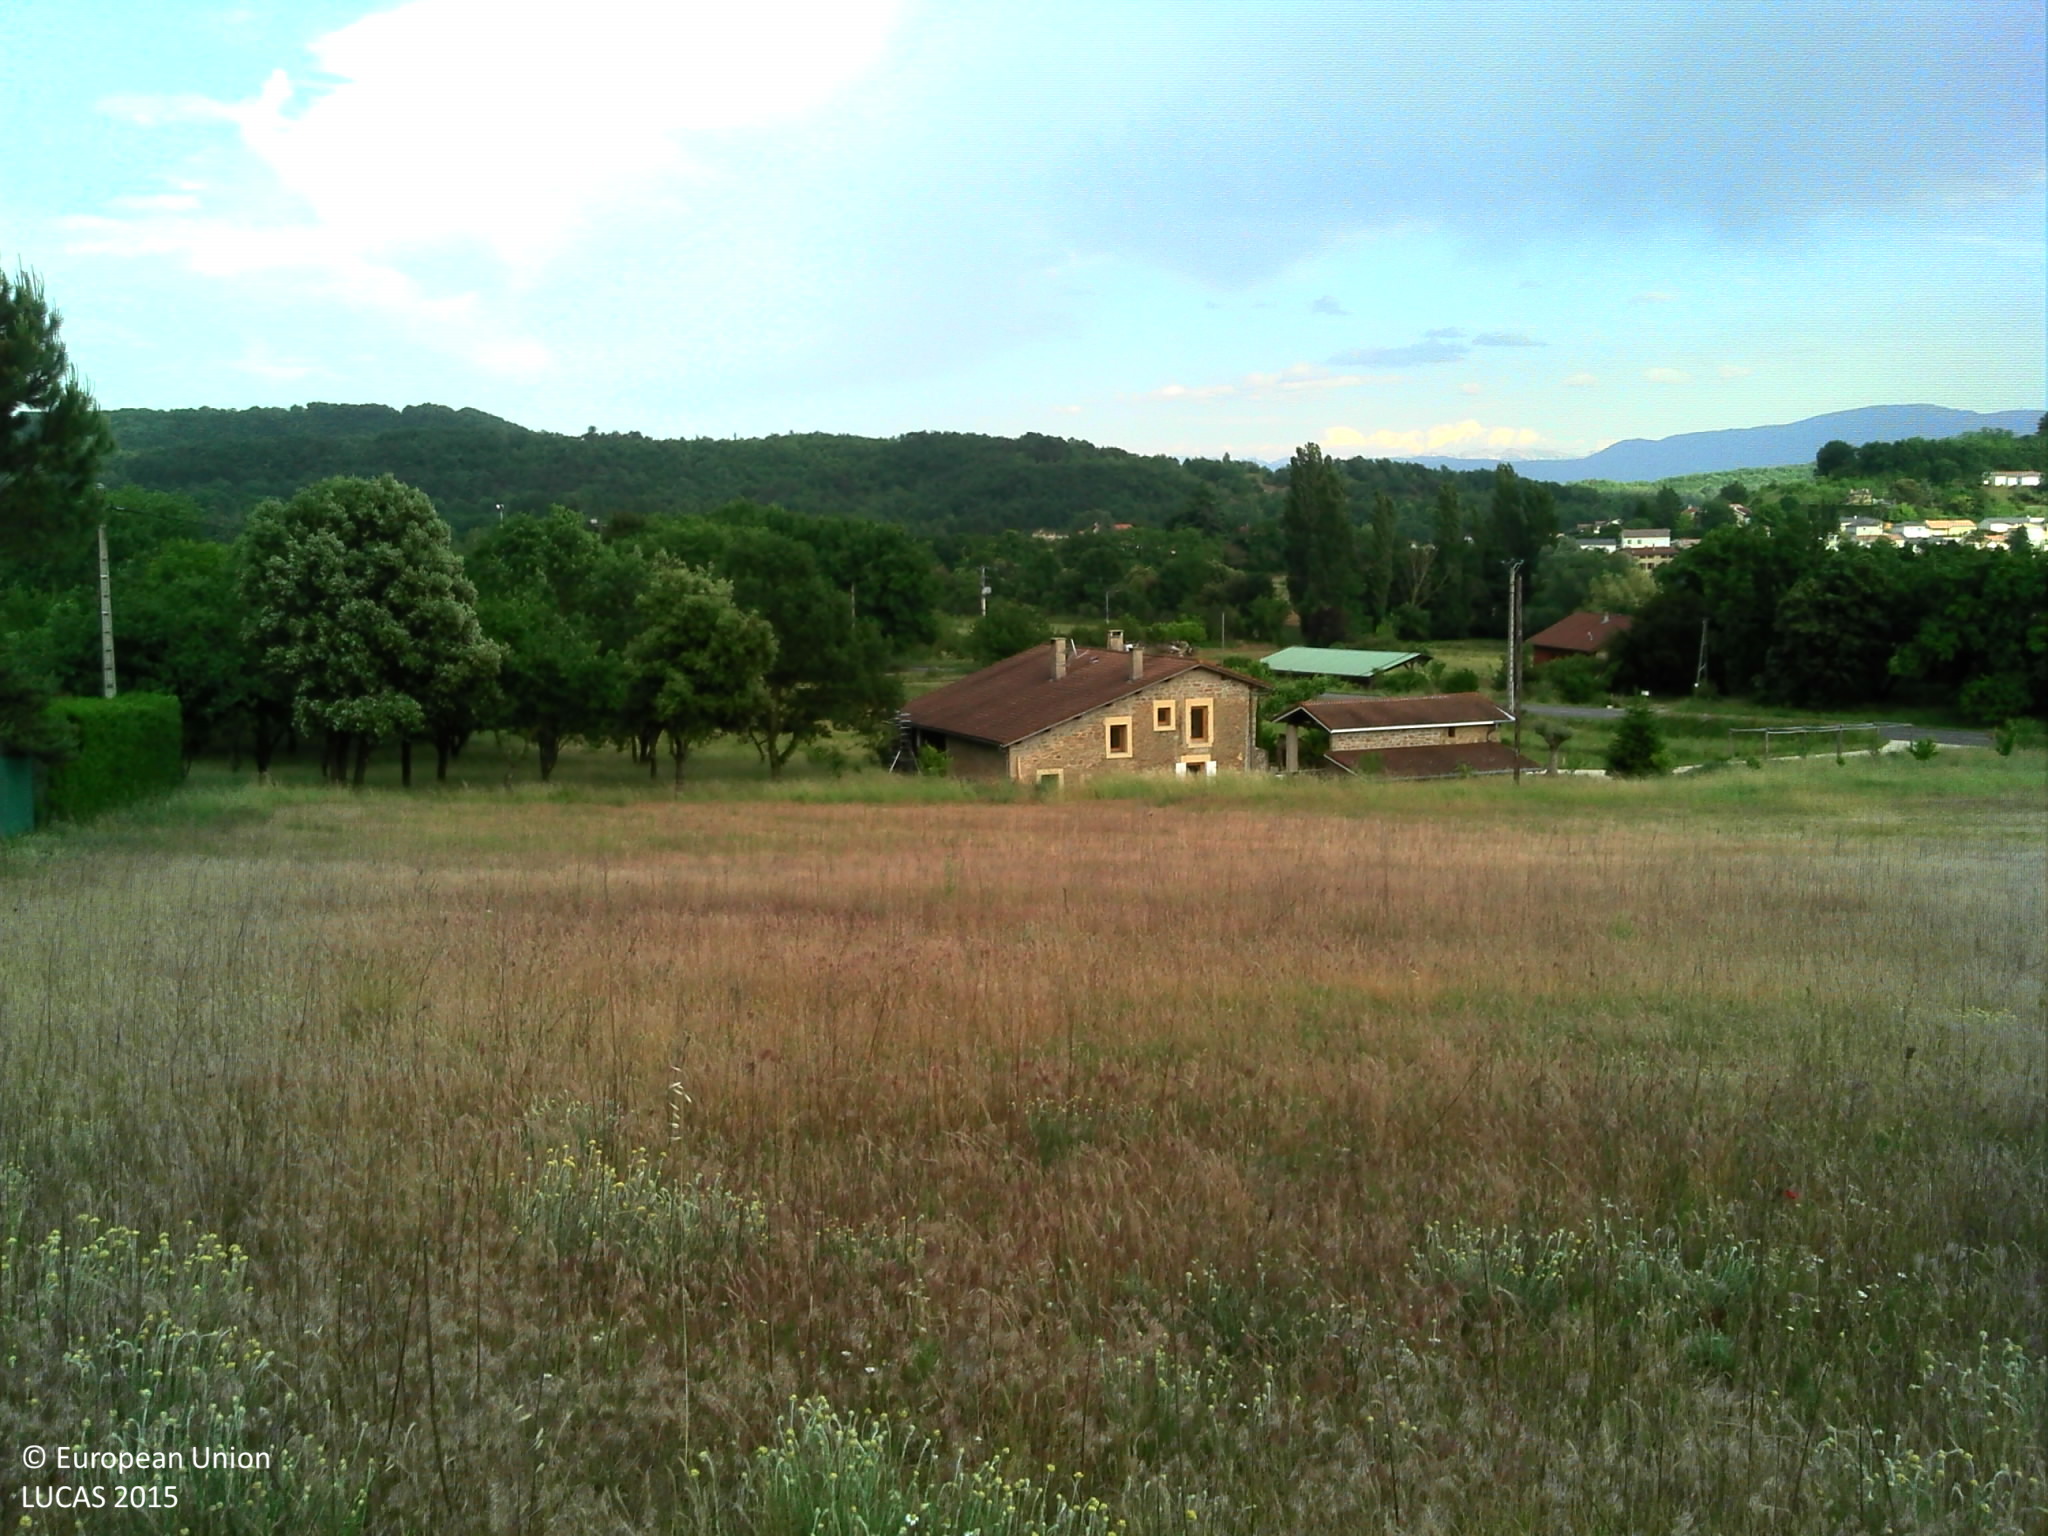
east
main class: Grassland
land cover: Grassland without tree/shrub cover
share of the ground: > 75 %
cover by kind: herbaceous plants 100 %
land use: Agriculture (excluding fallow land and kitchen gardens)
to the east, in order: Grassland without tree/shrub cover; Electric lines; Other fruit trees and berries; Grassland without tree/shrub cover; Tracks; Broadleaved woodland; Other bare soil; Broadleaved woodland; Paved roads, cycling and walking lanes
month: May
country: FR
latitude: 45.0988
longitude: 5.0367
